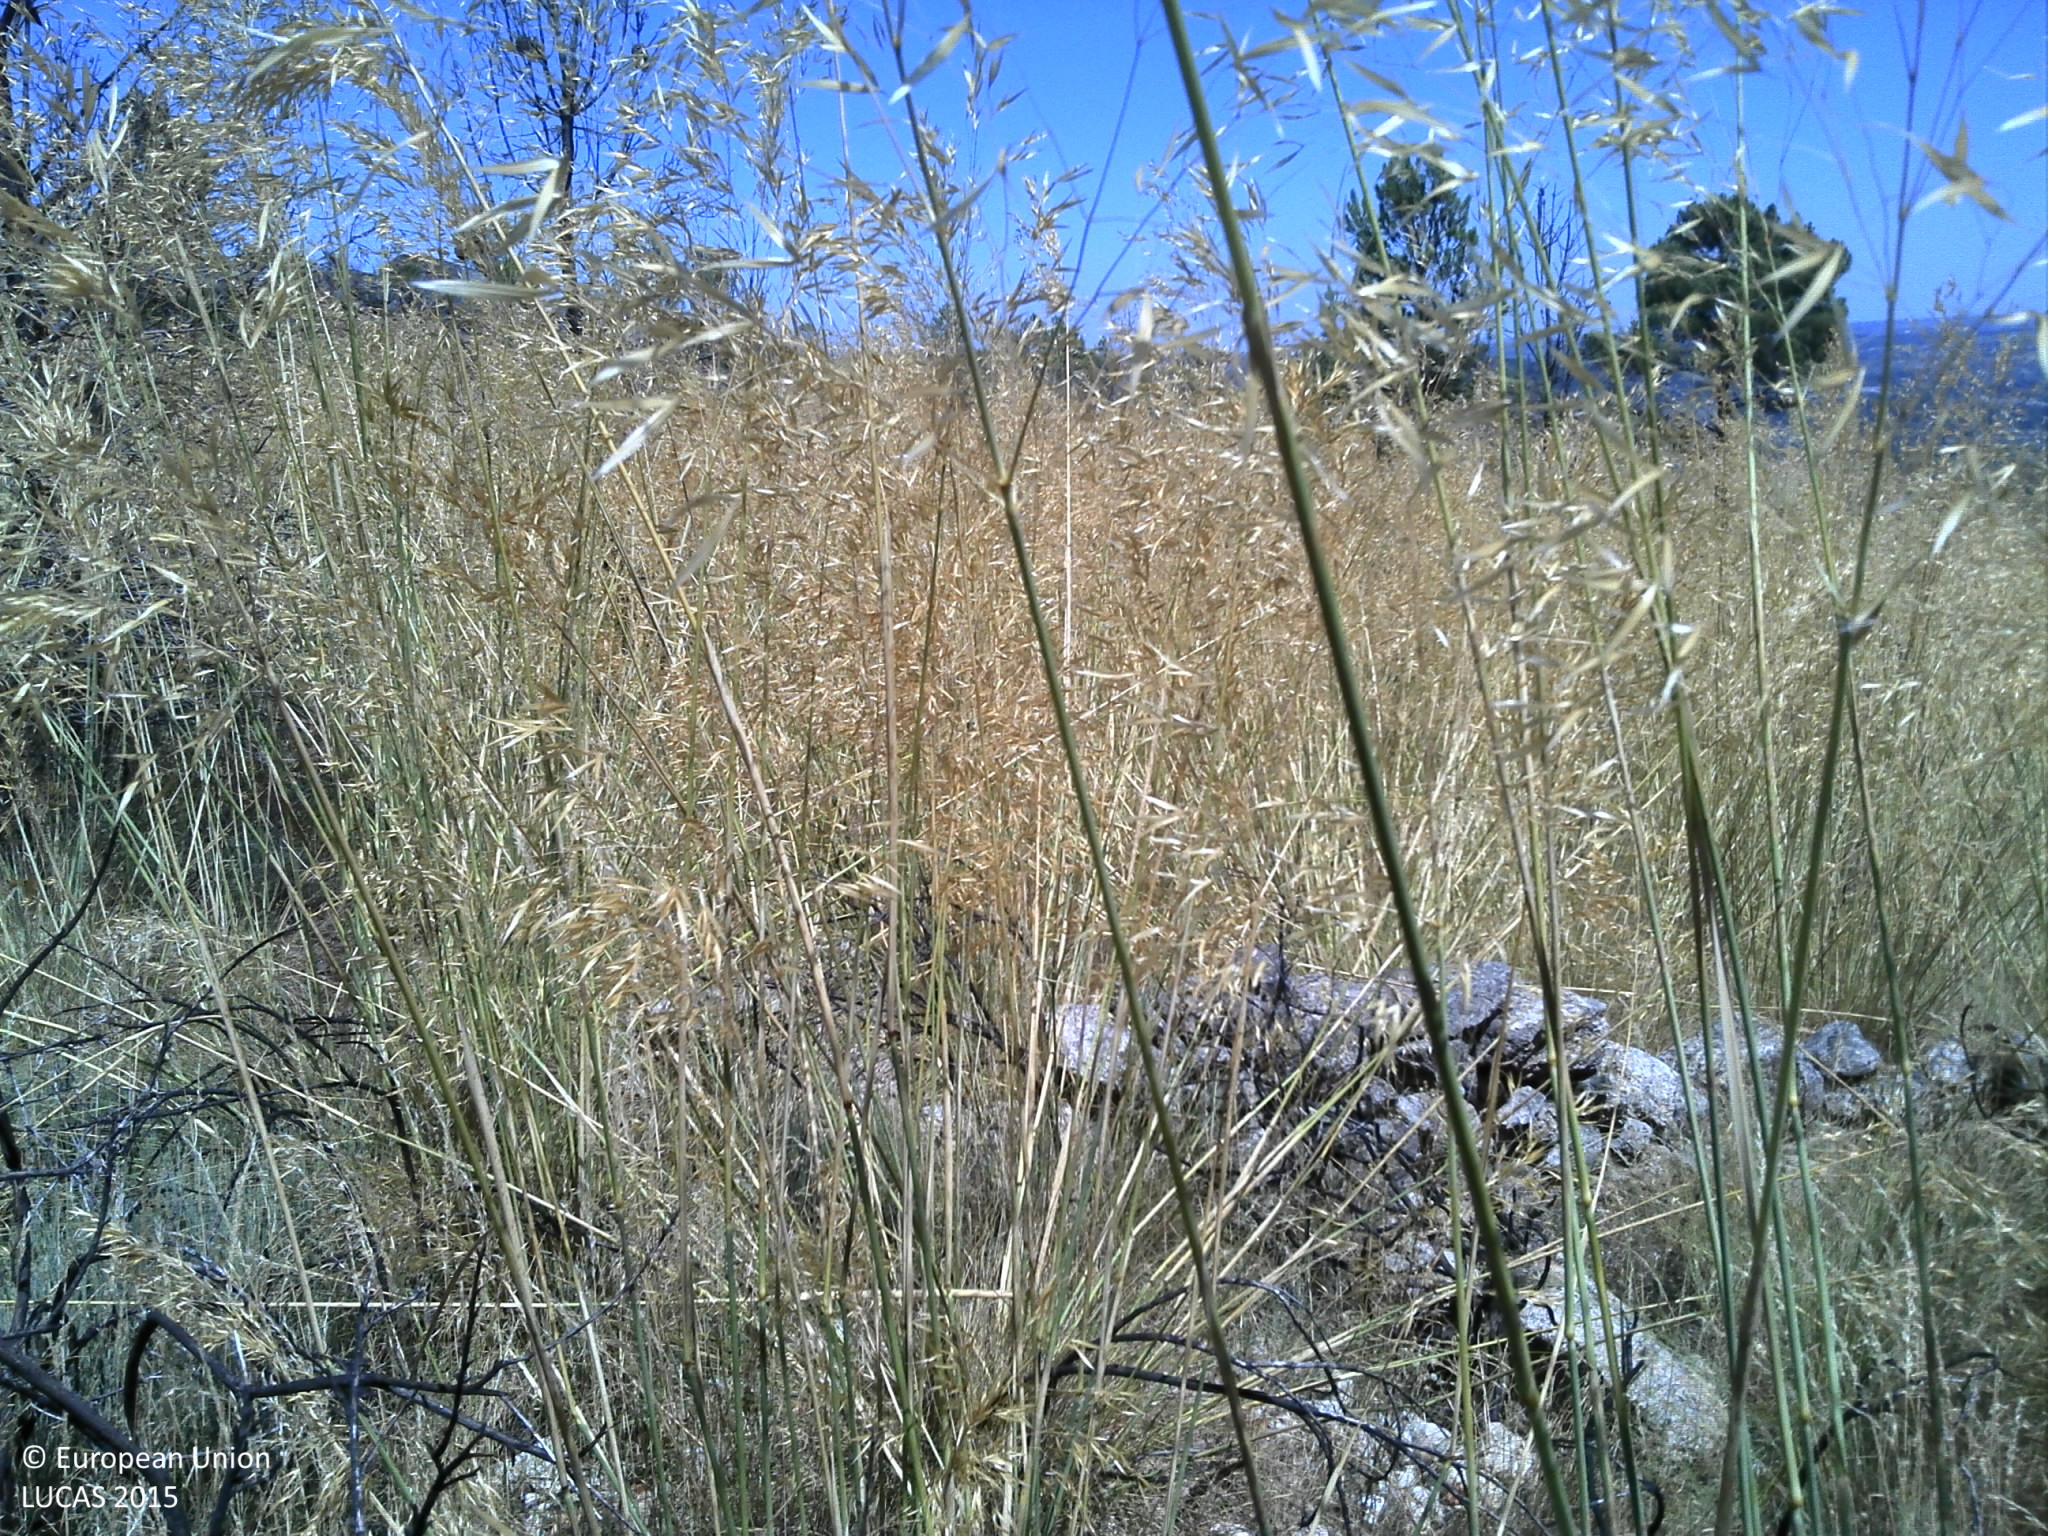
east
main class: Grassland
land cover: Spontaneously vegetated surfaces
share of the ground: 50 - 75 %
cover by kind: herbaceous plants 60 %, unconsolidated bare surface 40 %
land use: Semi-natural and natural areas not in use
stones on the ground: 10 - 25 %
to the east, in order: Spontaneously vegetated surfaces; Dry stone walls; Spontaneously vegetated surfaces; Single bushes/trees; Spontaneously vegetated surfaces; Rocks and stones; Spontaneously vegetated surfaces; Dry stone walls; Spontaneously vegetated surfaces; Dry stone walls; Shrubland without tree cover; Rock outcrops; Dry stone walls; Shrubland without tree cover; Single bushes/trees; Rock outcrops; Broadleaved woodland
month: June
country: PT
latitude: 40.7350
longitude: -7.3641
